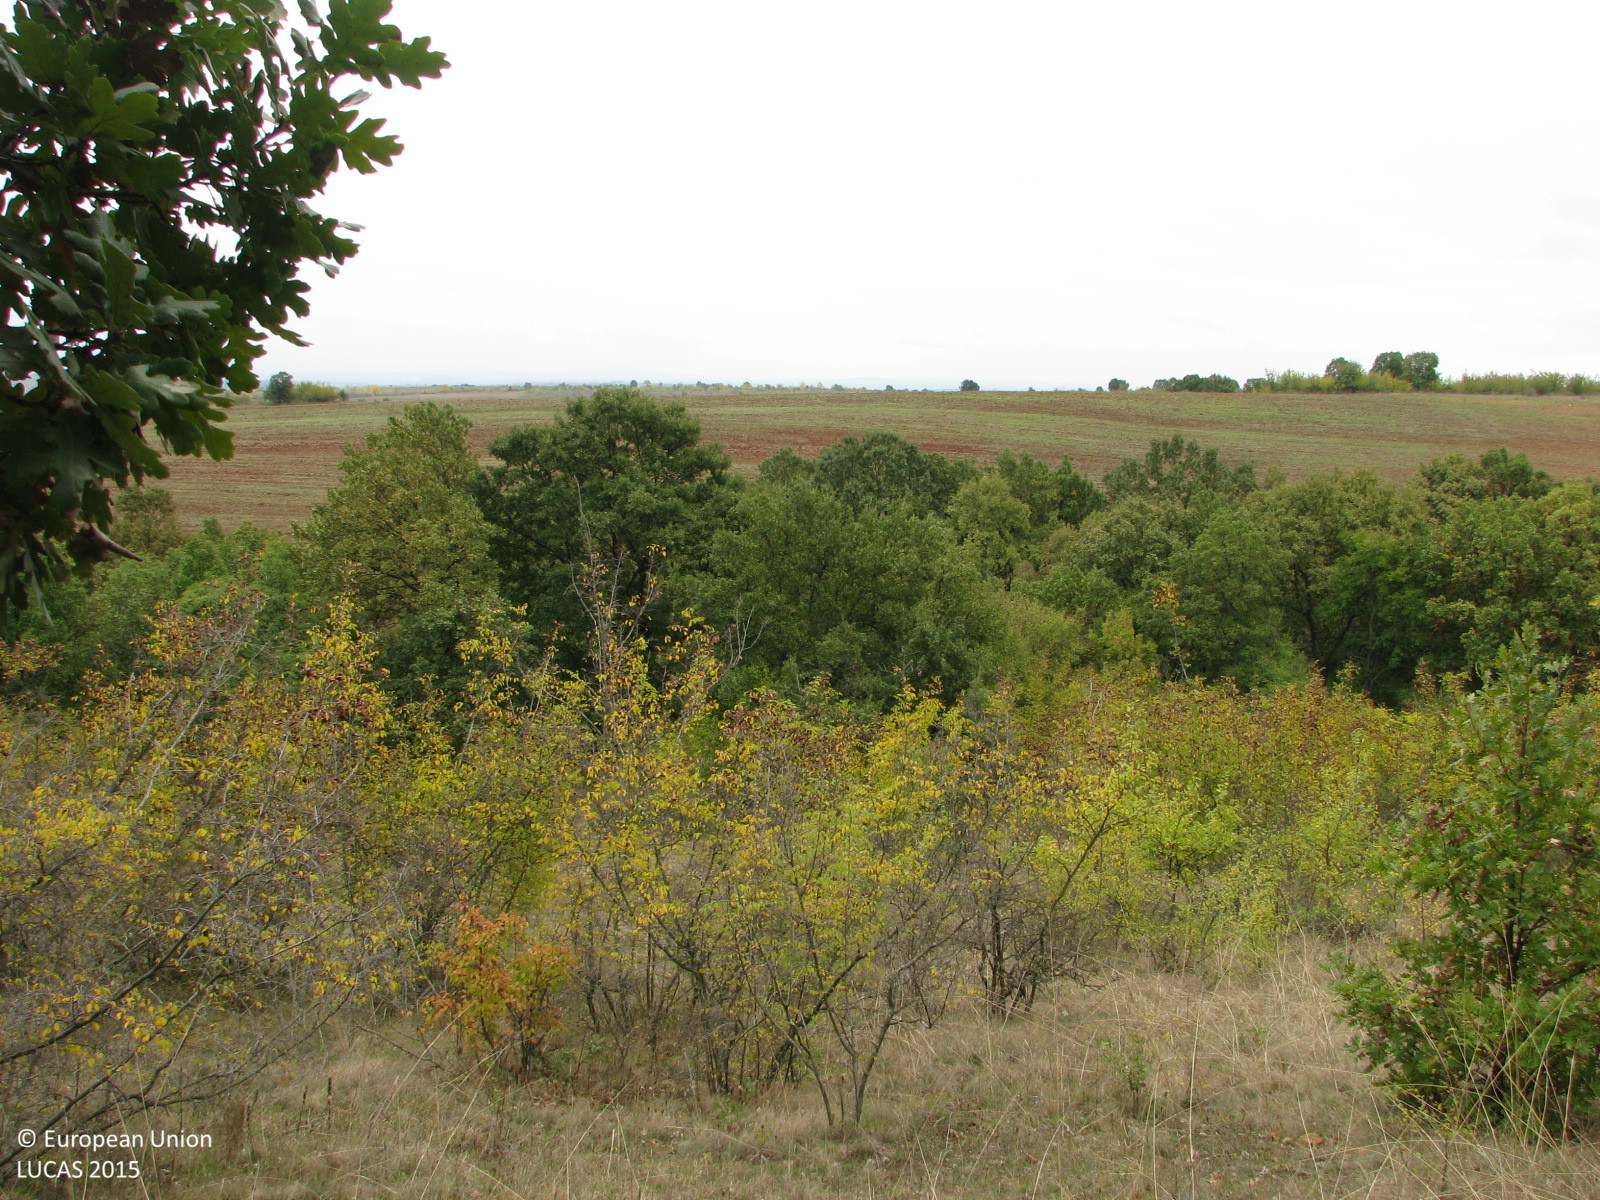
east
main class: Woodland
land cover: Broadleaved woodland
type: mesophytic deciduous forest
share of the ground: 50 - 75 %
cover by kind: broadleaved forest trees 65 %, herbaceous plants 20 %, shrubs 15 %
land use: Forestry
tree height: < 5 m
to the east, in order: Broadleaved woodland; Grassland with sparse tree/shrub cover; Shrubland without tree cover; Tracks; Broadleaved woodland; Grassland without tree/shrub cover; Broadleaved woodland; Inland fresh running water; Broadleaved woodland; Grassland without tree/shrub cover; Tracks; Other bare soil
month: October
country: BG
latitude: 42.1274
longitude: 26.3297
